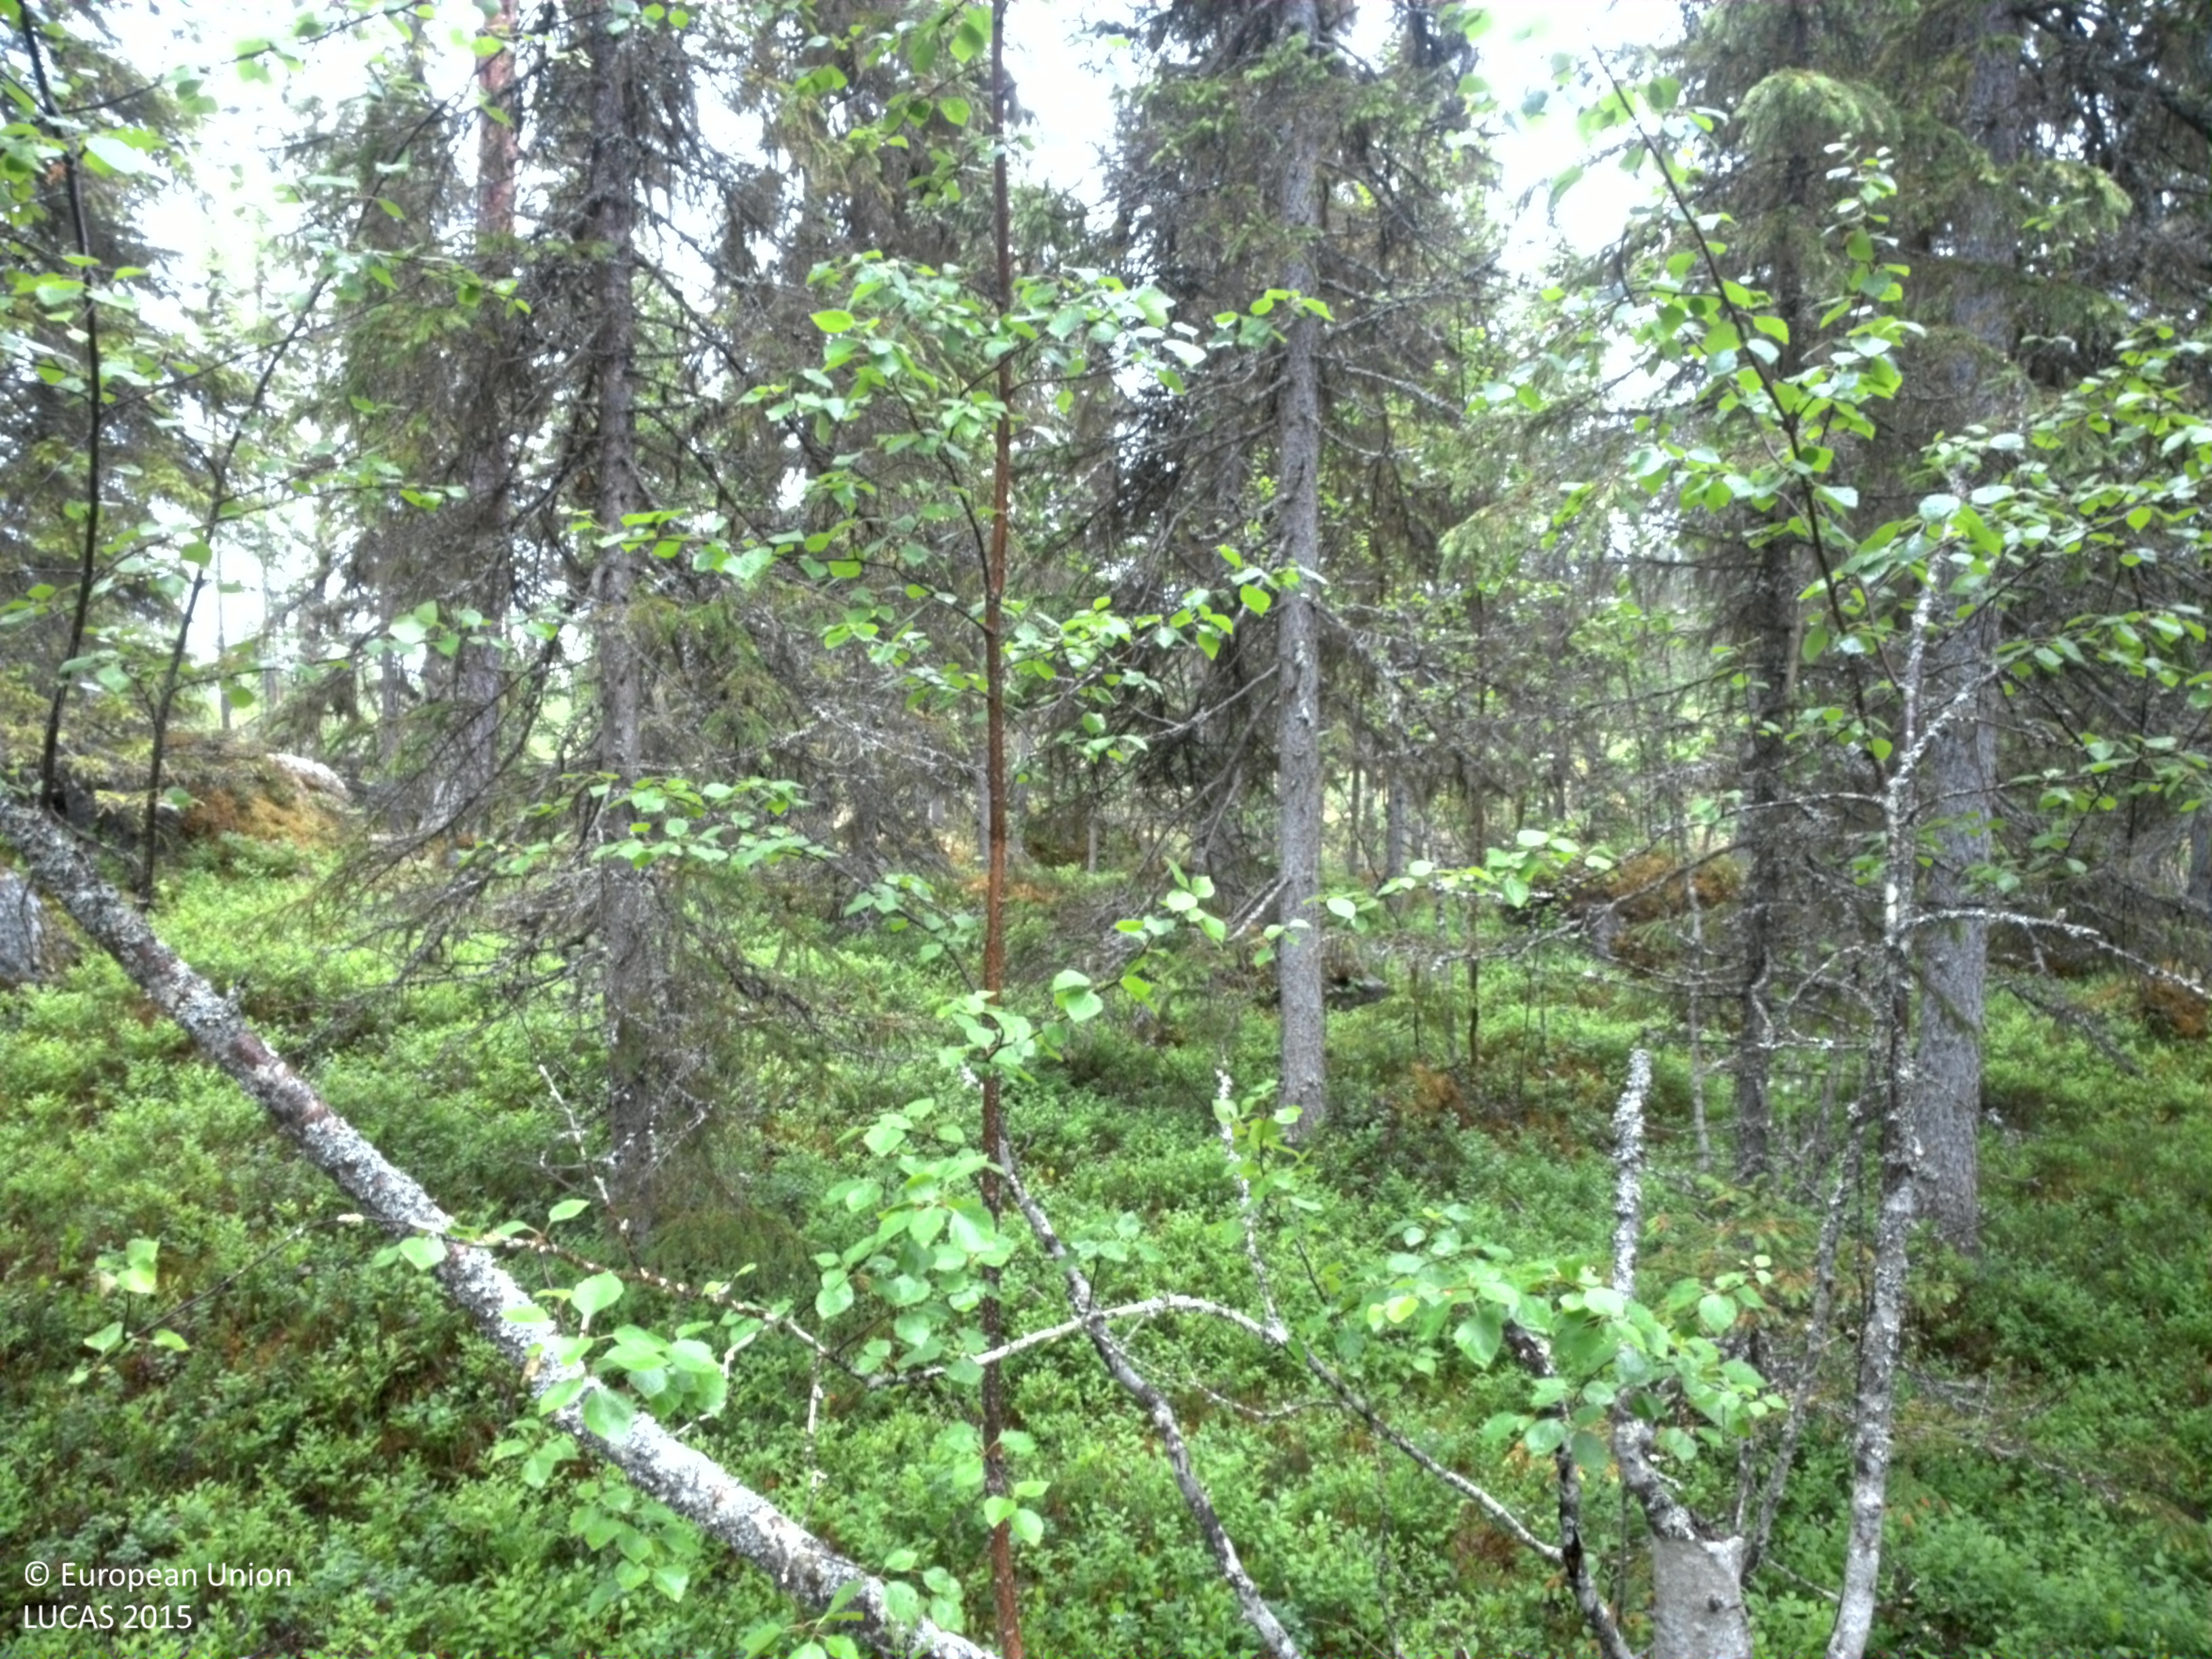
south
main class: Woodland
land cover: Other coniferous woodland
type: boreal forest
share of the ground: 25 - 50 %
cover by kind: coniferous forest trees 45 %, shrubs 40 %, lichens and mosses 10 %, broadleaved forest trees 5 %
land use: Forestry
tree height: > 5 m
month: July
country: SE
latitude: 64.6007
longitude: 18.2626
